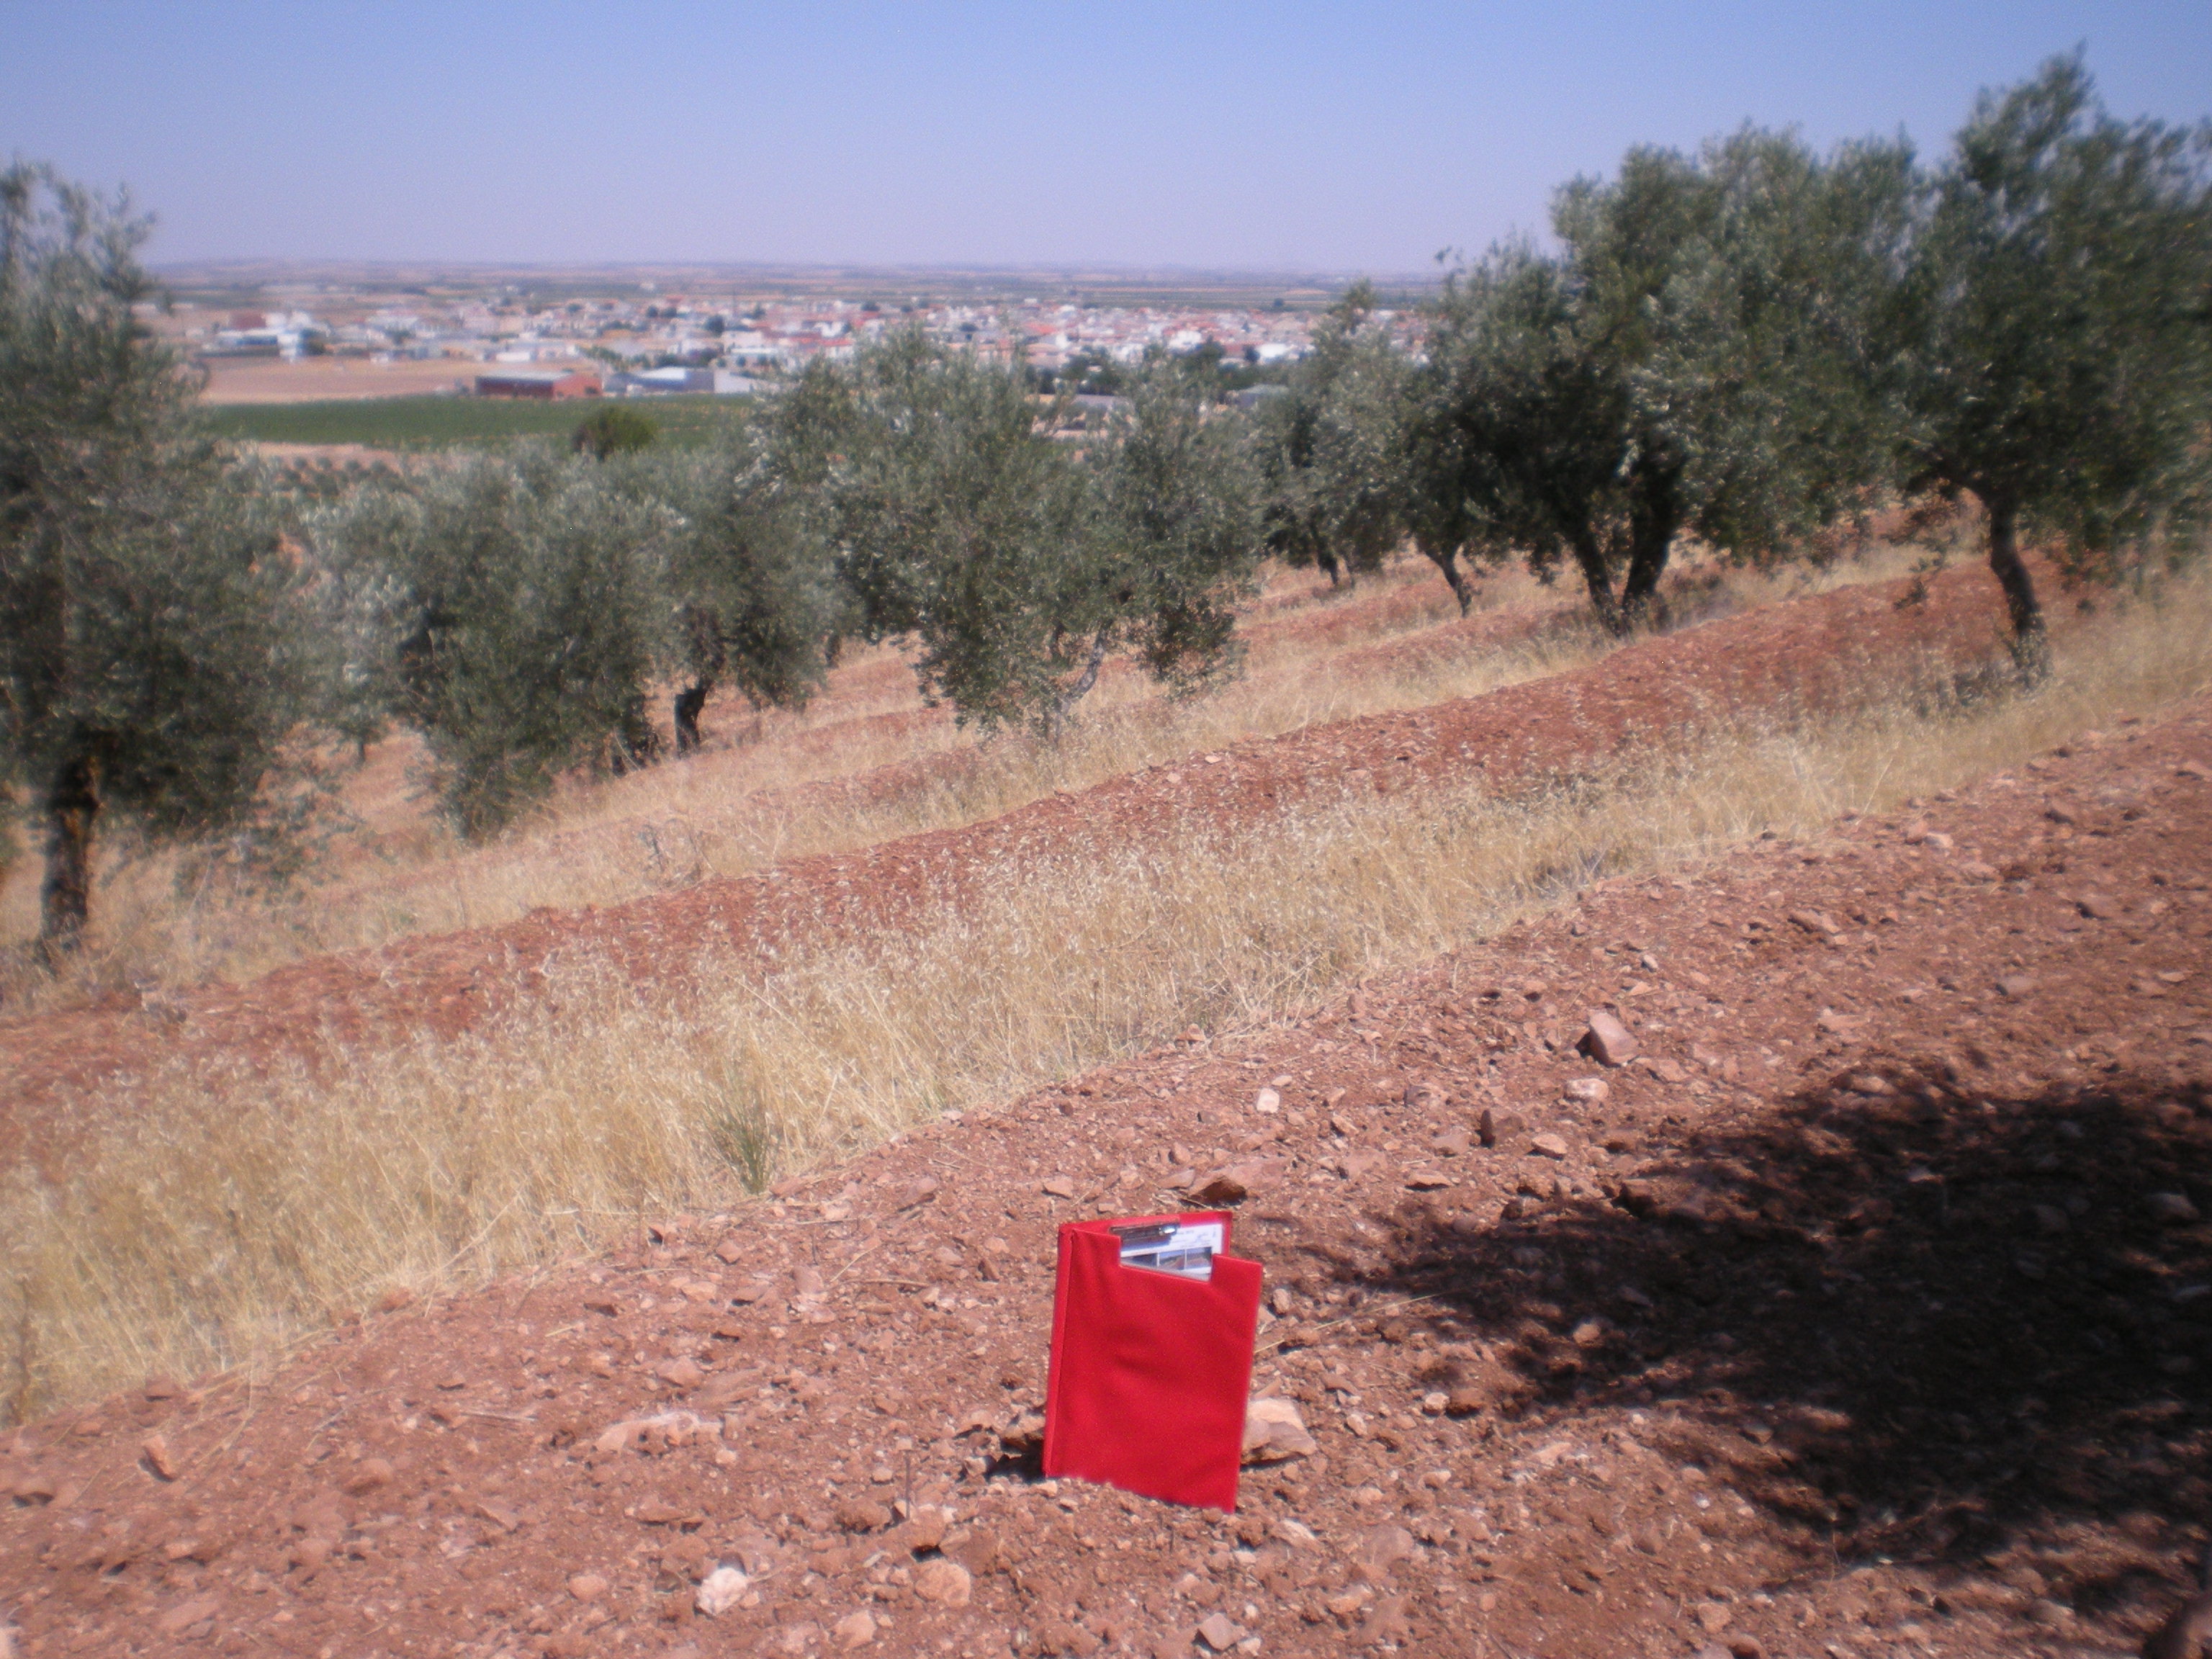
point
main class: Cropland
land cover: Olive groves
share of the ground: 25 - 50 %
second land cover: Spontaneously vegetated surfaces
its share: 10 - 25 %
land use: Agriculture (excluding fallow land and kitchen gardens)
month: July
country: ES
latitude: 39.3502
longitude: -3.3520
